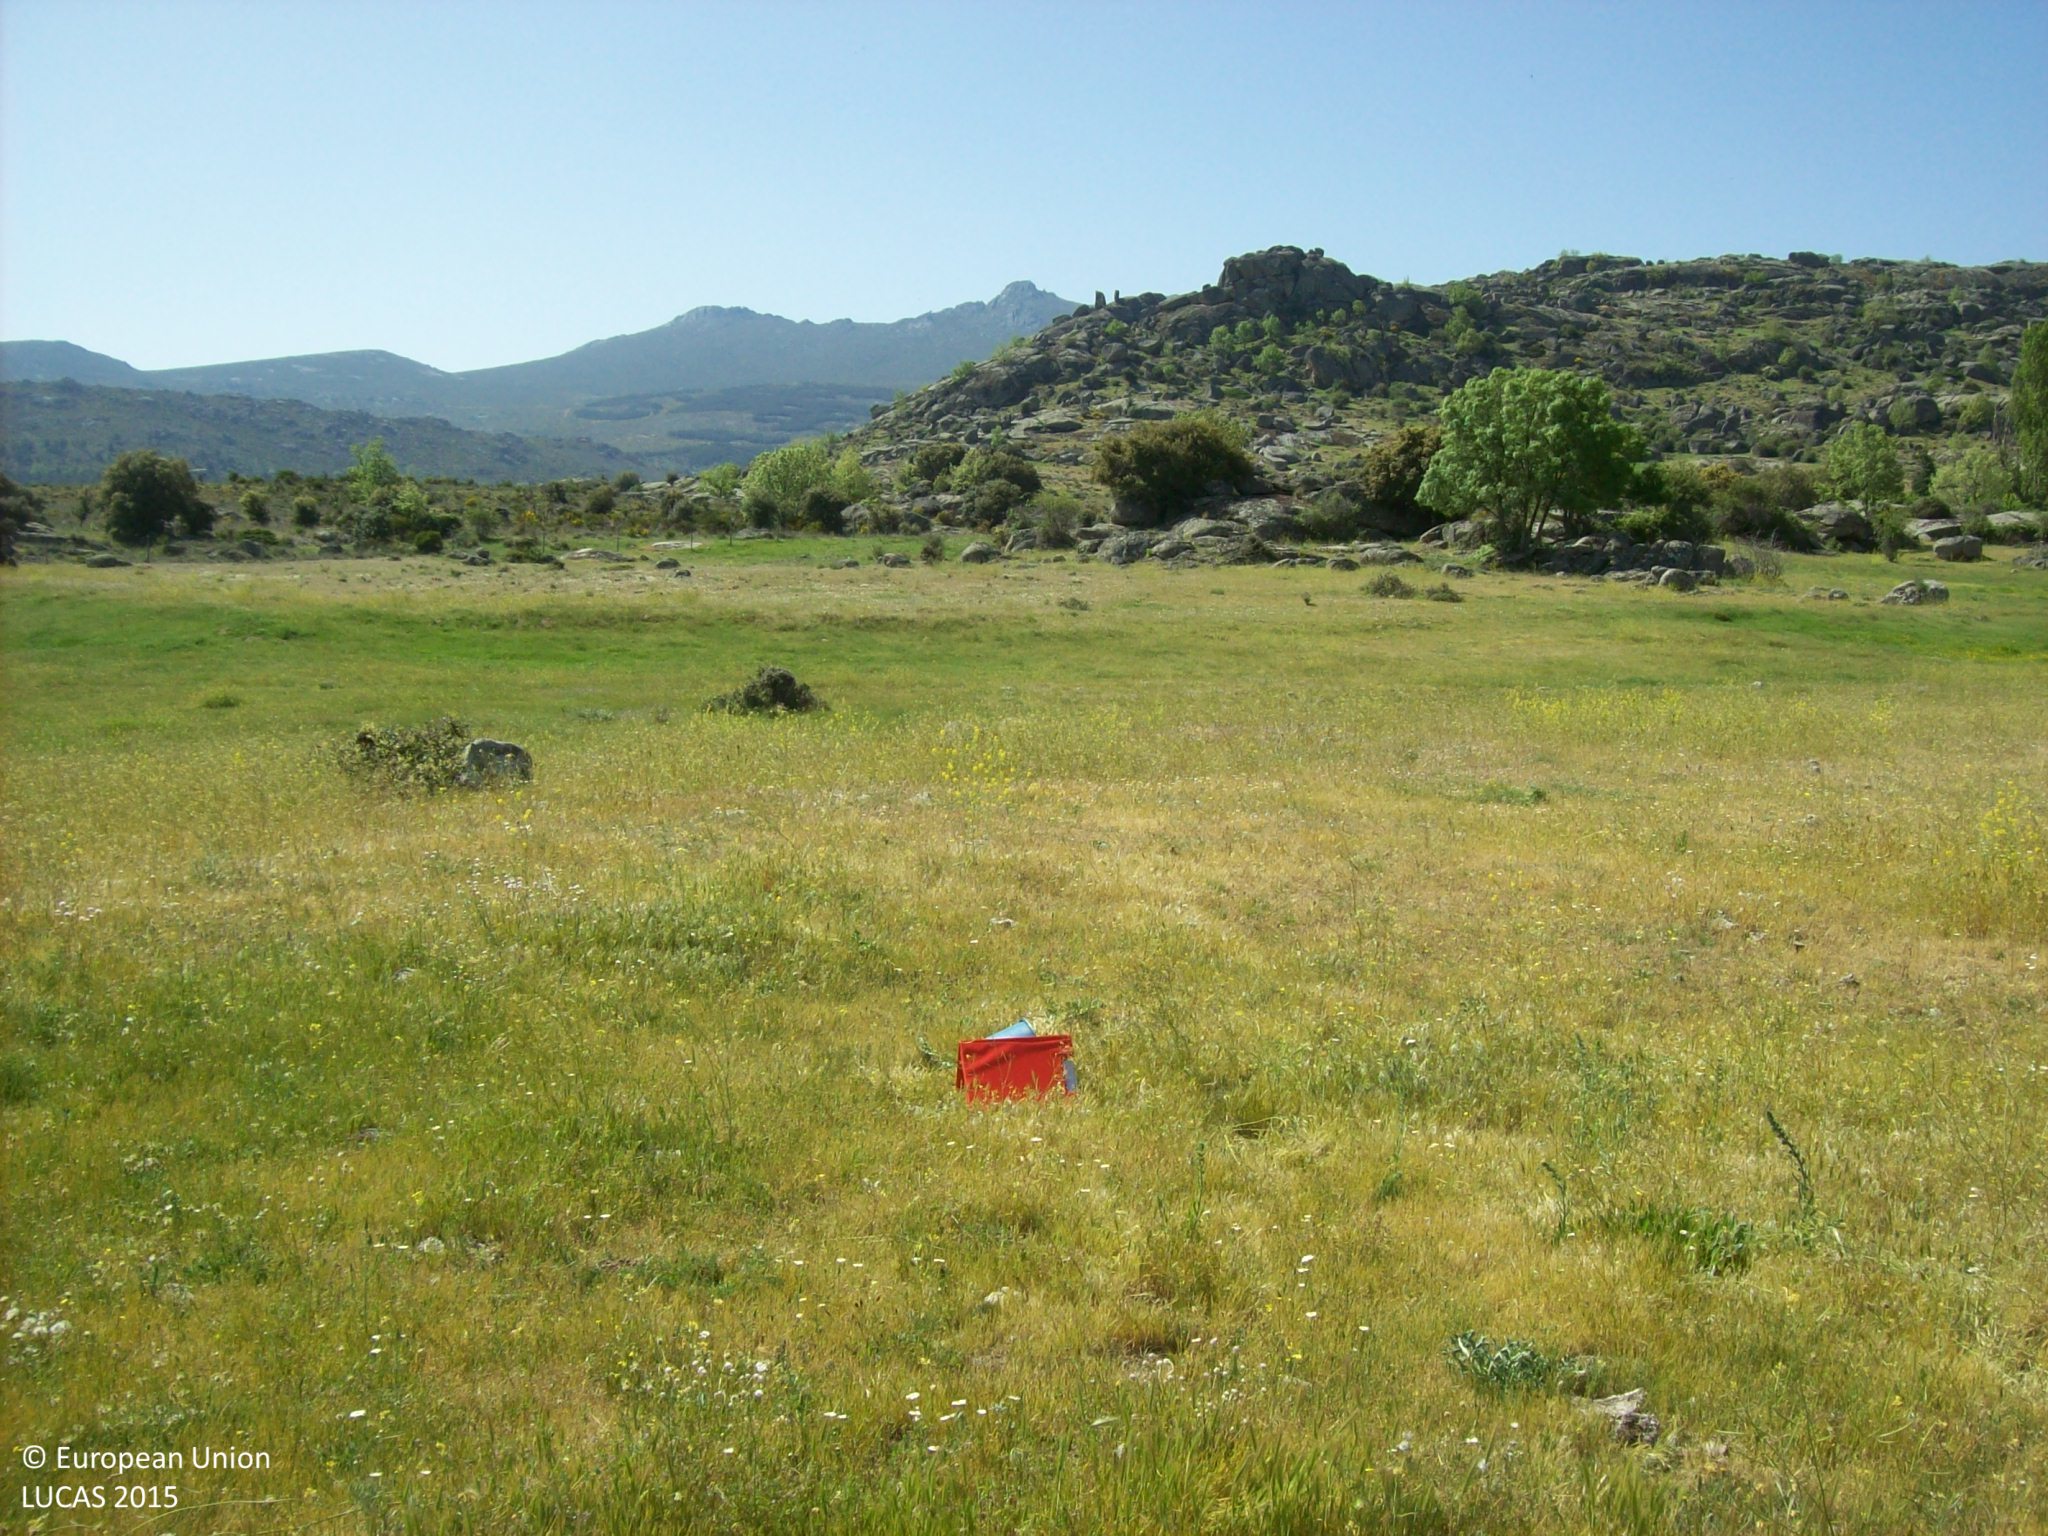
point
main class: Grassland
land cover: Grassland without tree/shrub cover
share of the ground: > 75 %
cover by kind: herbaceous plants 95 %, shrubs 5 %
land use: Agriculture (excluding fallow land and kitchen gardens)
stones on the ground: < 10 %
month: May
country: ES
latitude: 40.5399
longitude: -4.8743
